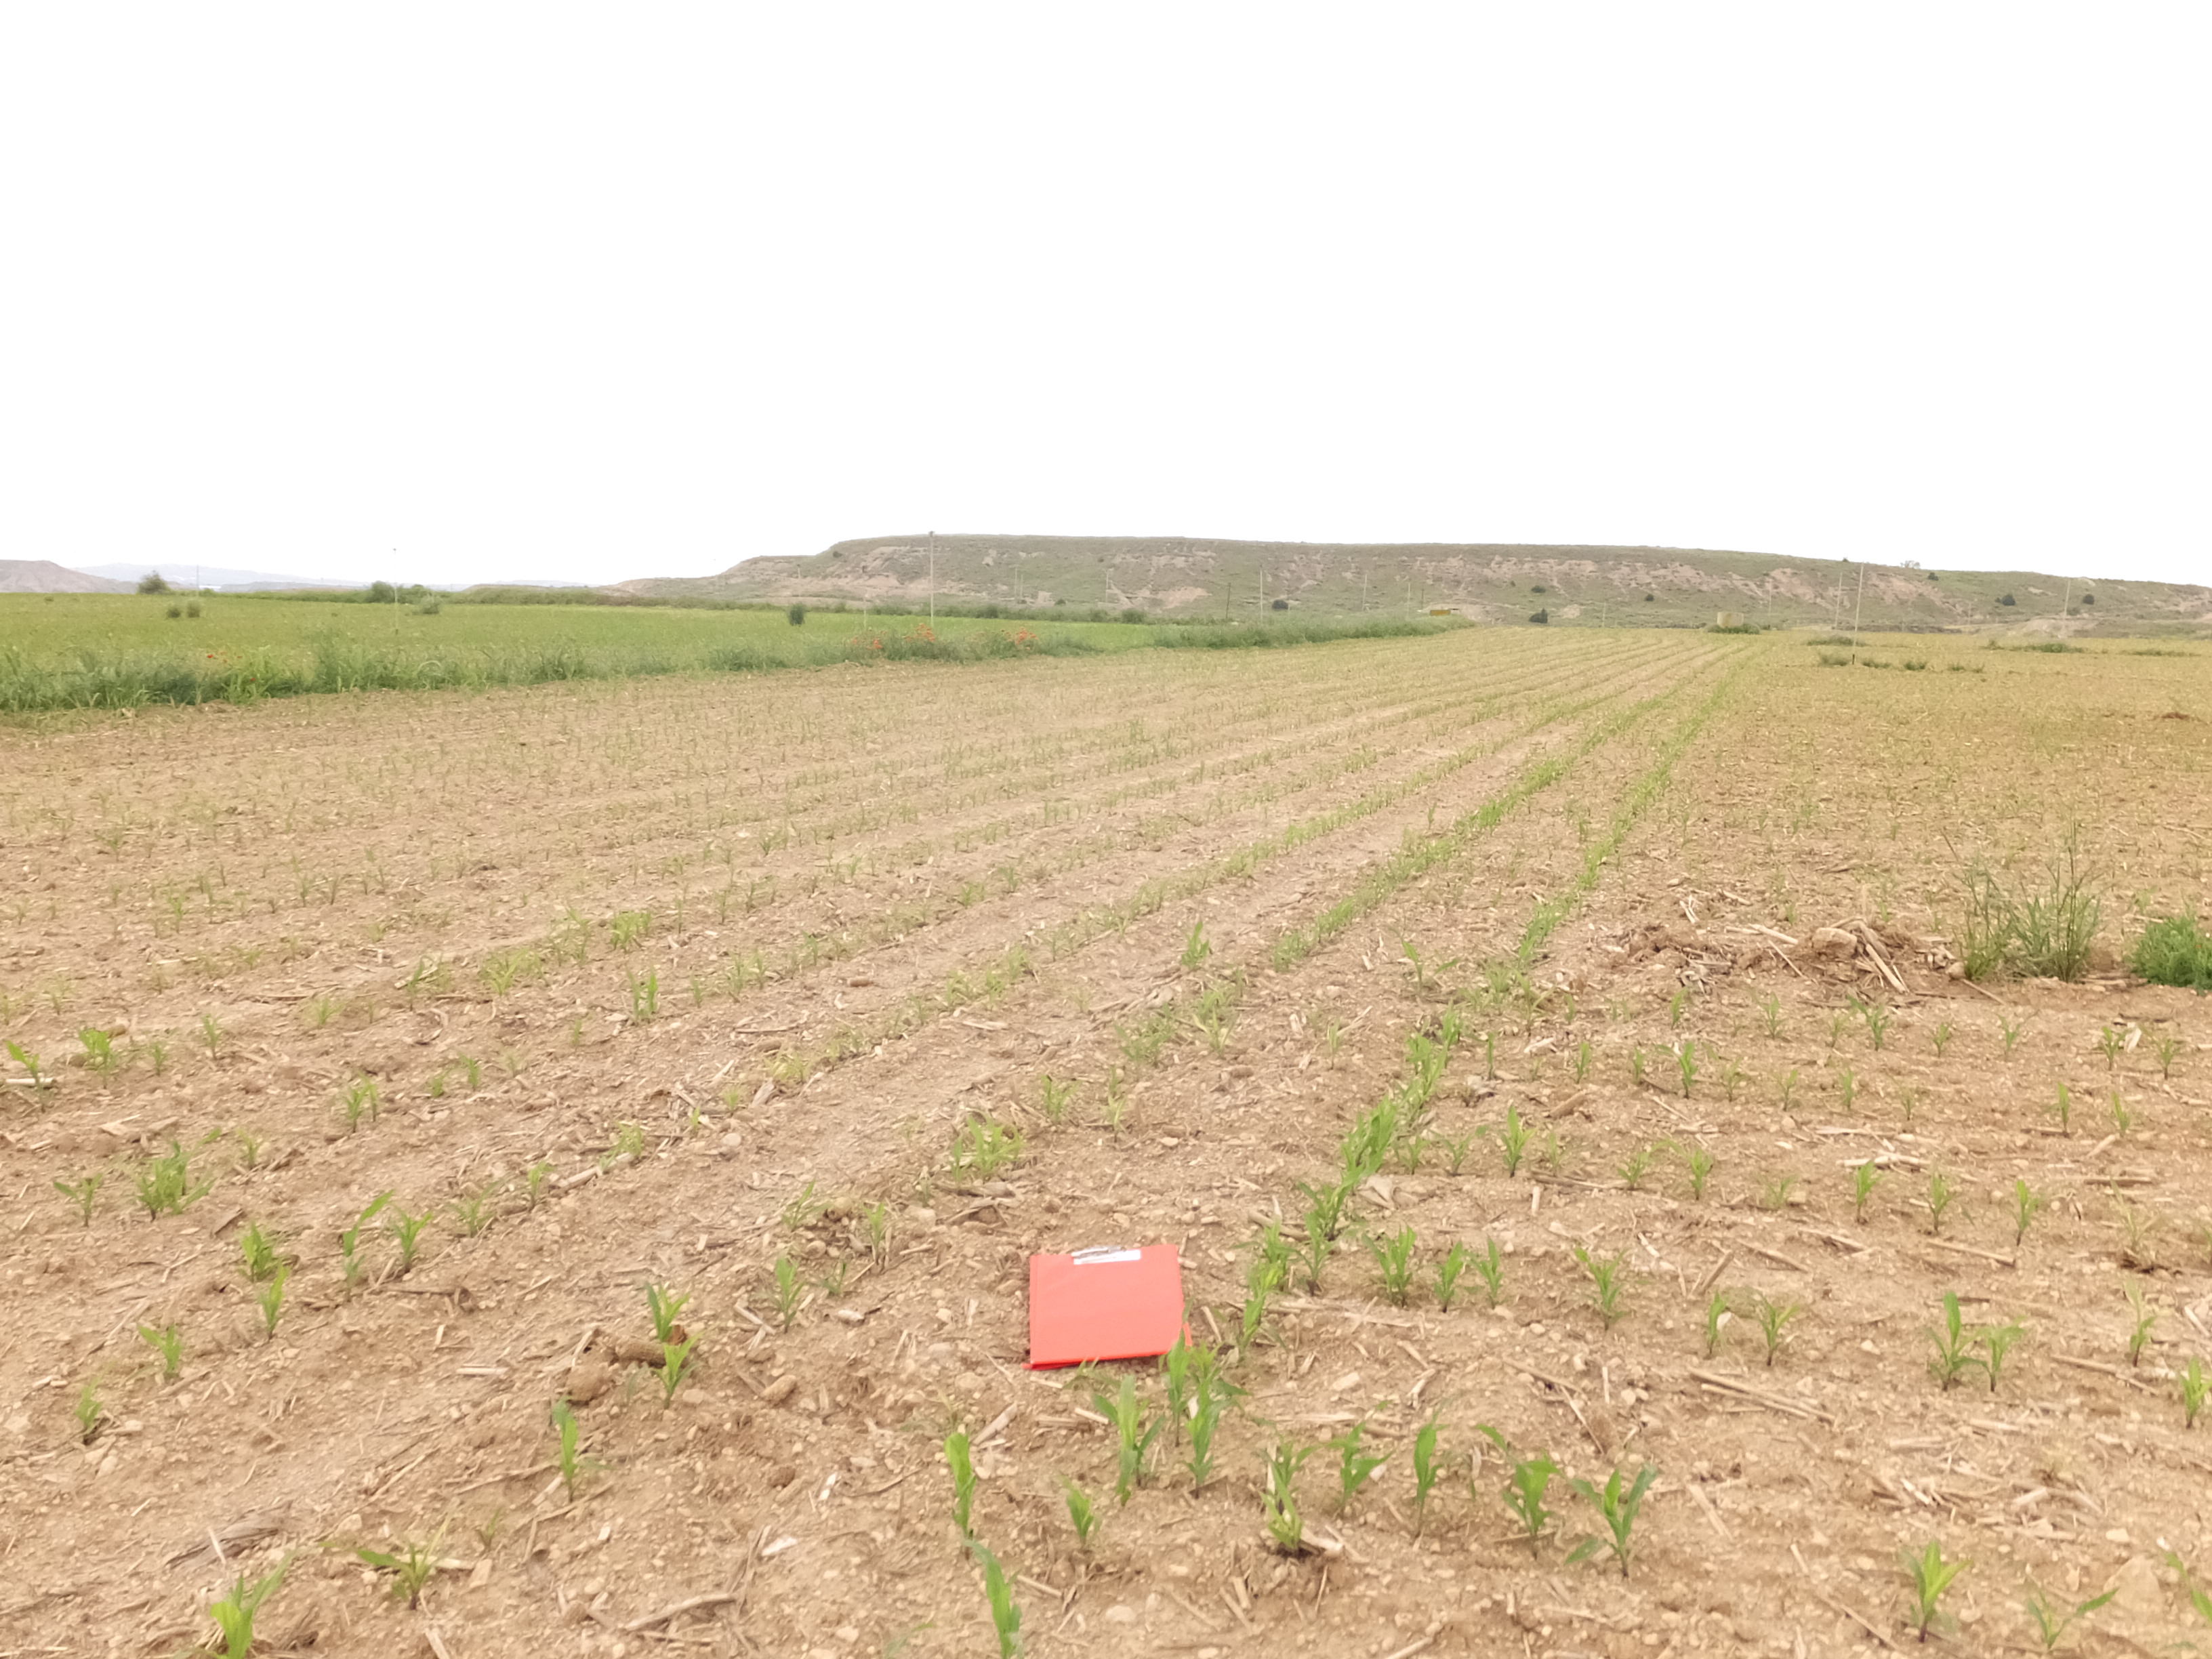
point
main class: Cropland
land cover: Maize
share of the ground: < 10 %
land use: Agriculture (excluding fallow land and kitchen gardens)
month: May
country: ES
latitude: 41.7170
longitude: -0.2225
